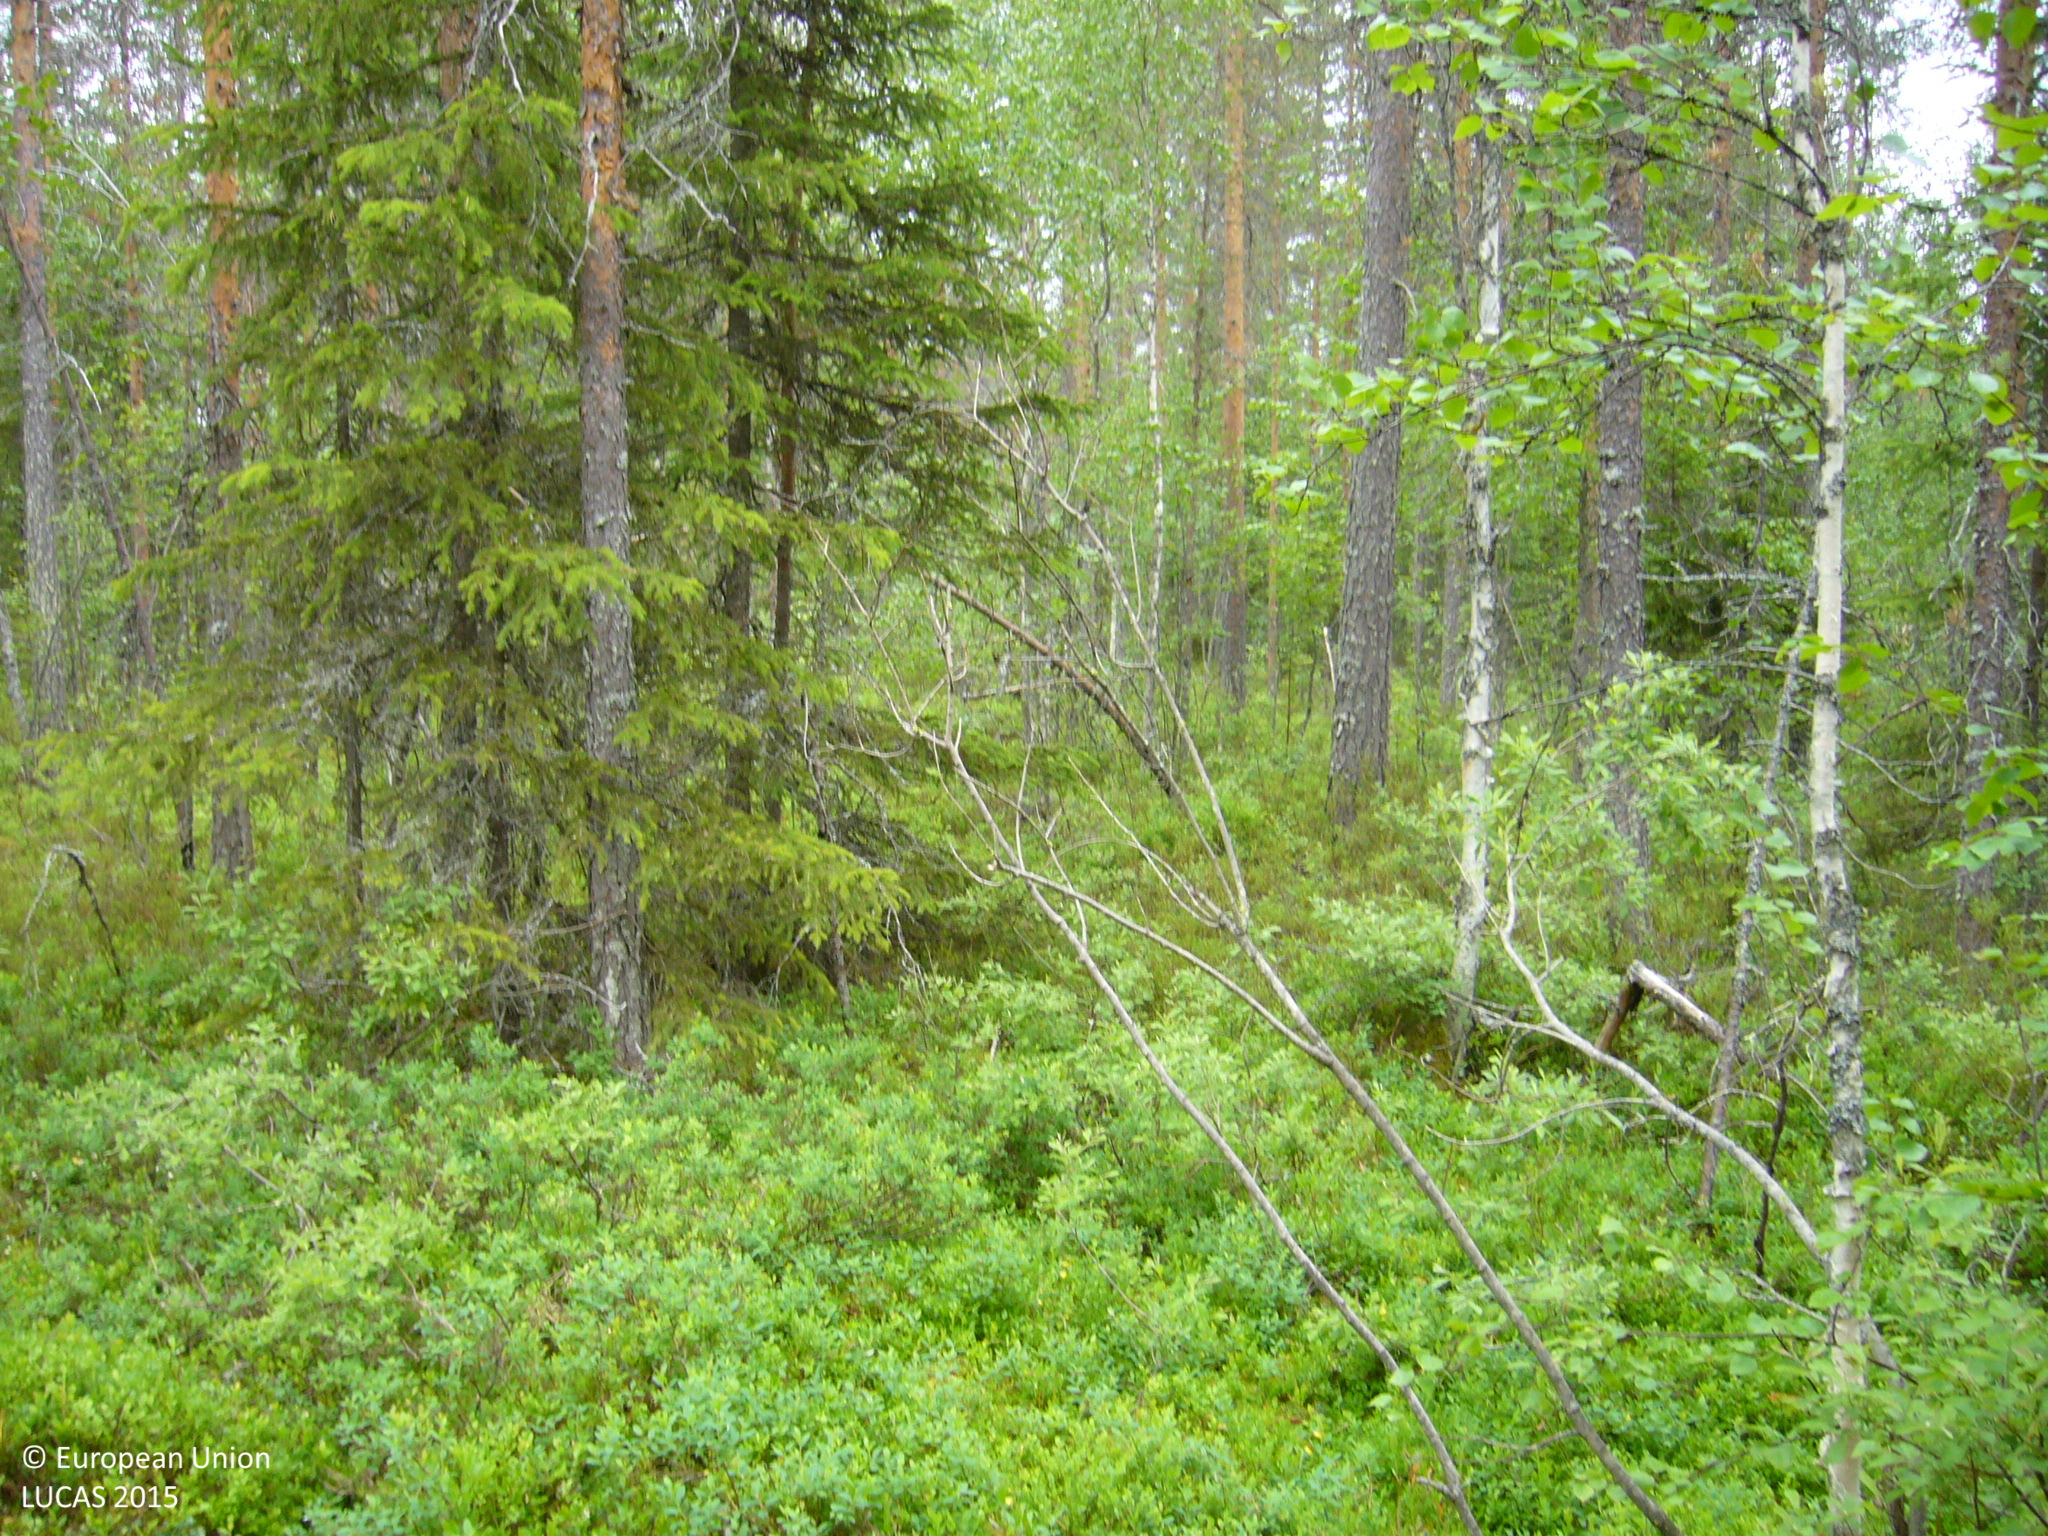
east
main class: Woodland
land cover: Pine dominated mixed woodland
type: boreal forest
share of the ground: 50 - 75 %
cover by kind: coniferous forest trees 40 %, shrubs 35 %, broadleaved forest trees 25 %
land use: Forestry
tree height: > 5 m
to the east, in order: Pine dominated mixed woodland; Ditches and canals; Pine dominated mixed woodland; Ditches and canals; Pine dominated mixed woodland; Ditches and canals; Other mixed woodland; Pine dominated mixed woodland
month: July
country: FI
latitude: 63.4338
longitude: 25.9662
